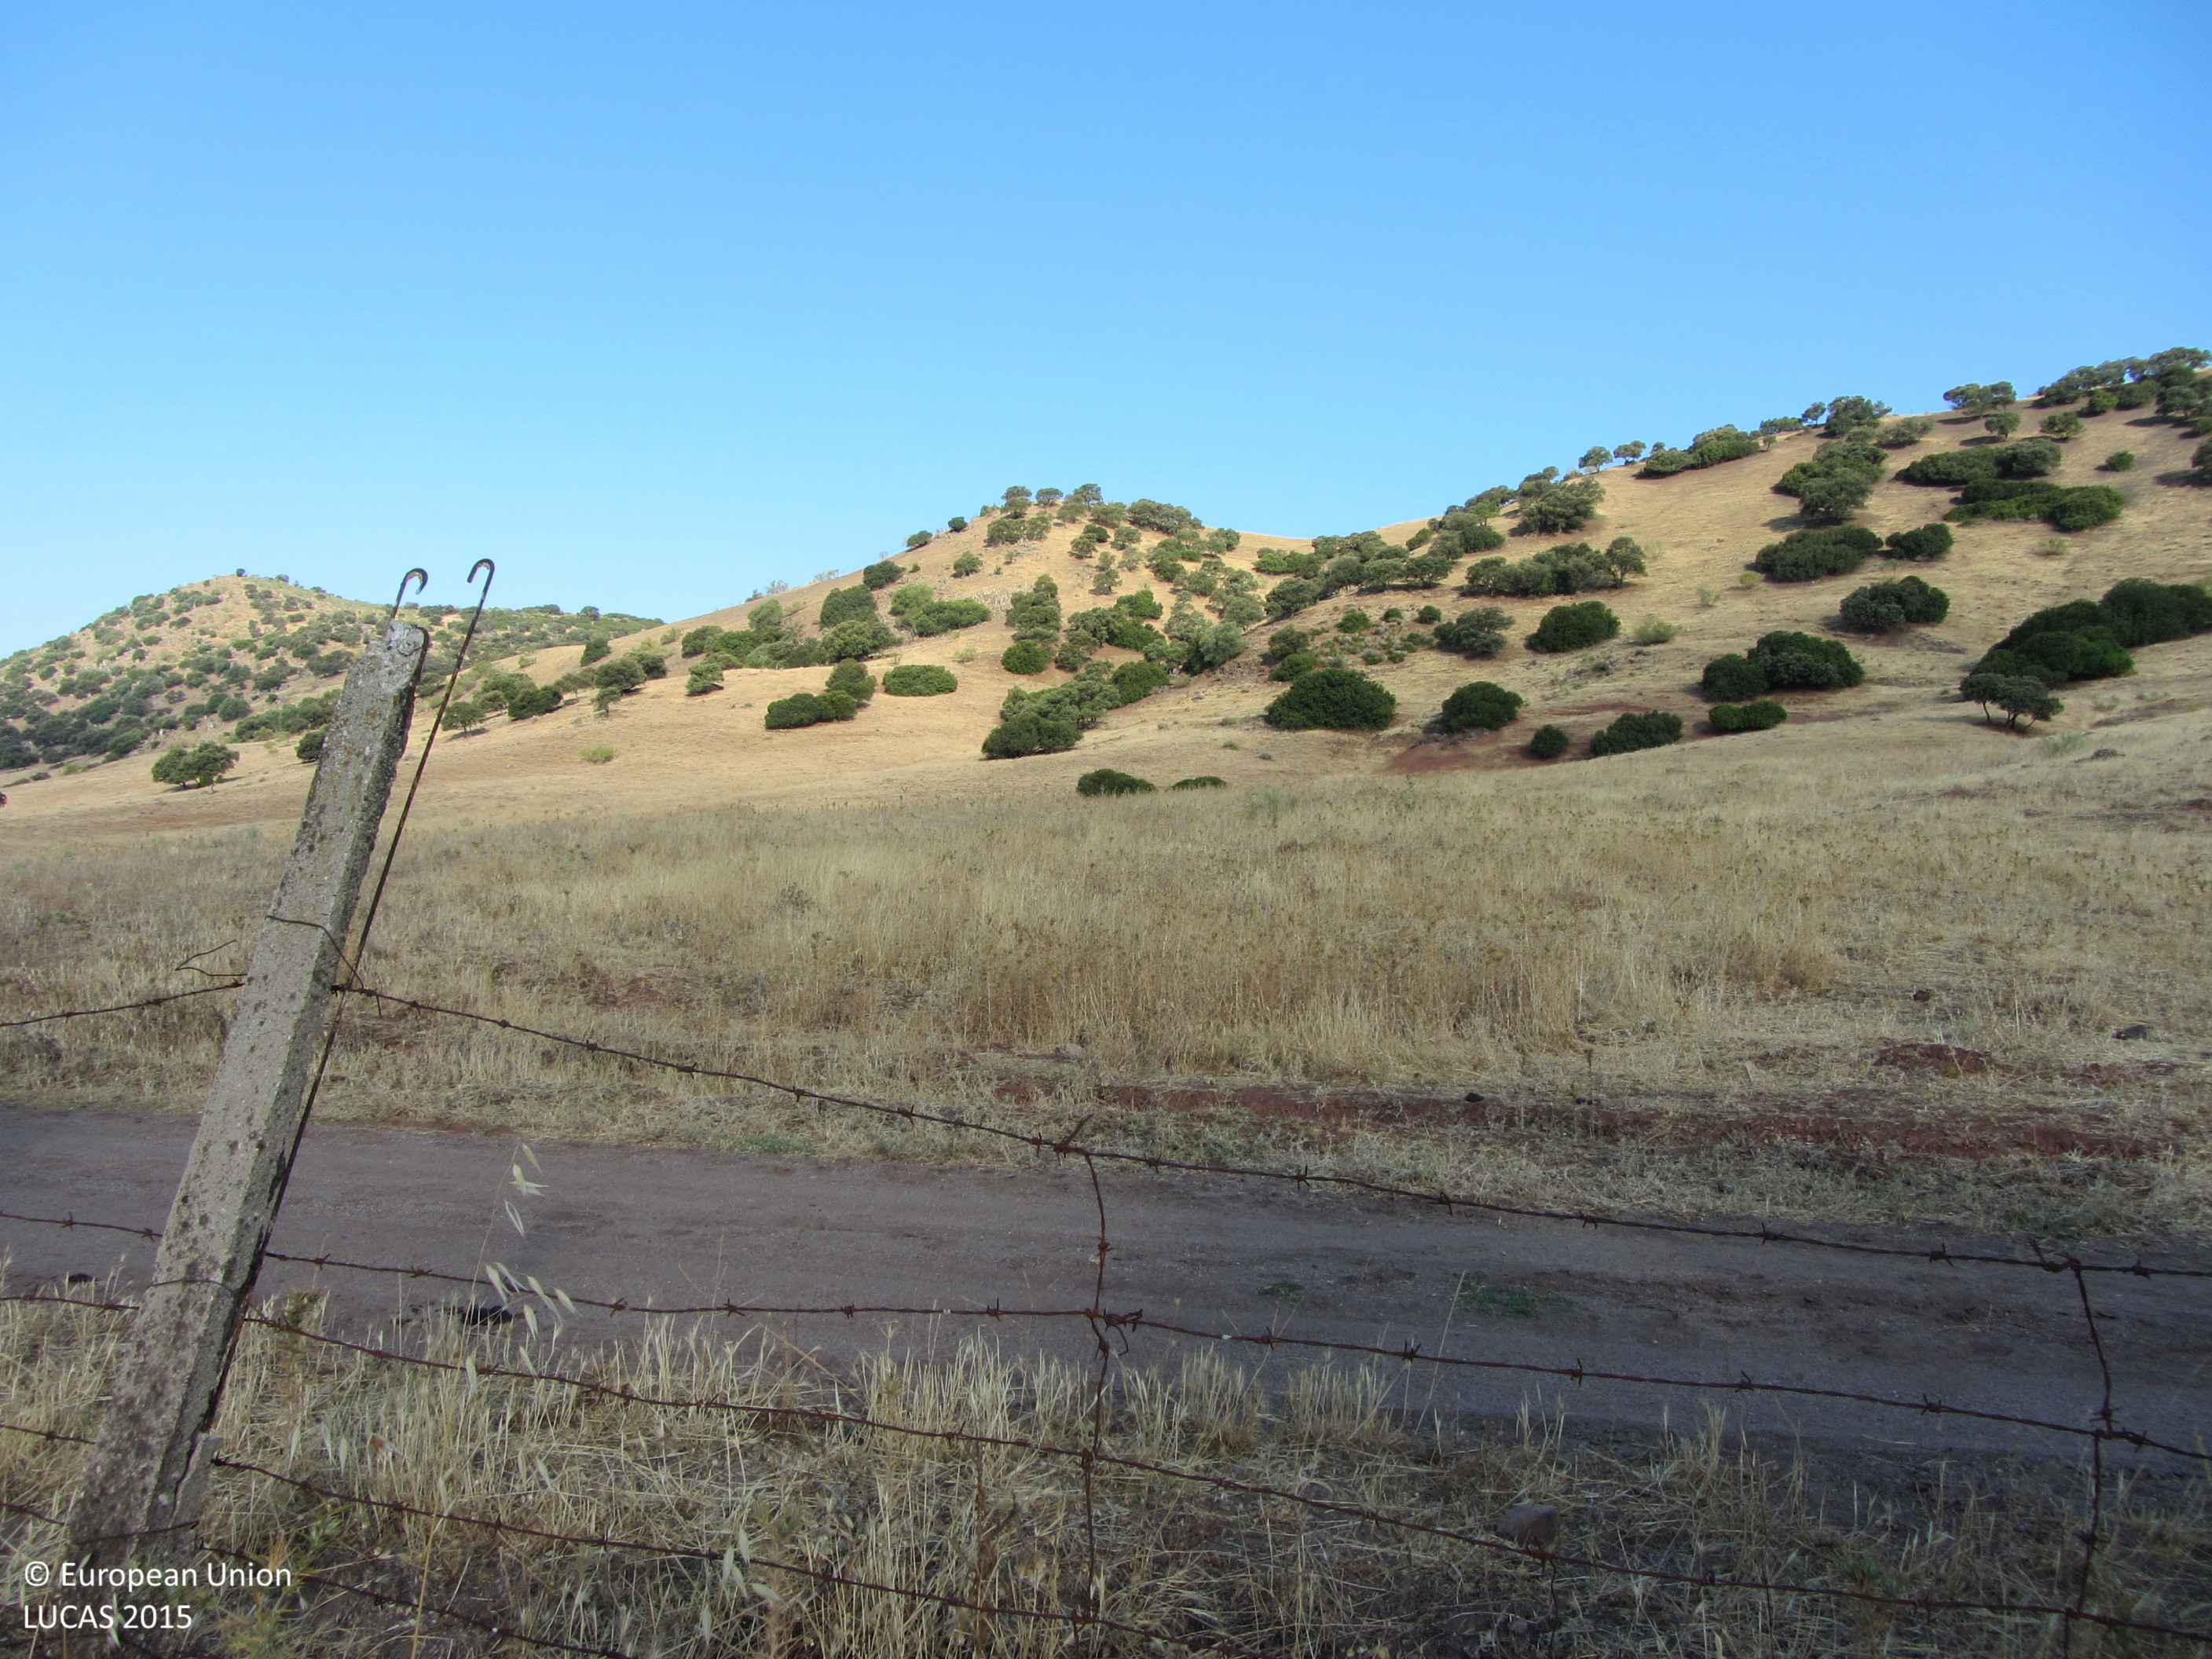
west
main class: Grassland
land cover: Grassland without tree/shrub cover
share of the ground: > 75 %
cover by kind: herbaceous plants 100 %
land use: Agriculture (excluding fallow land and kitchen gardens)
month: June
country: ES
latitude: 38.1476
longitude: -3.4333
